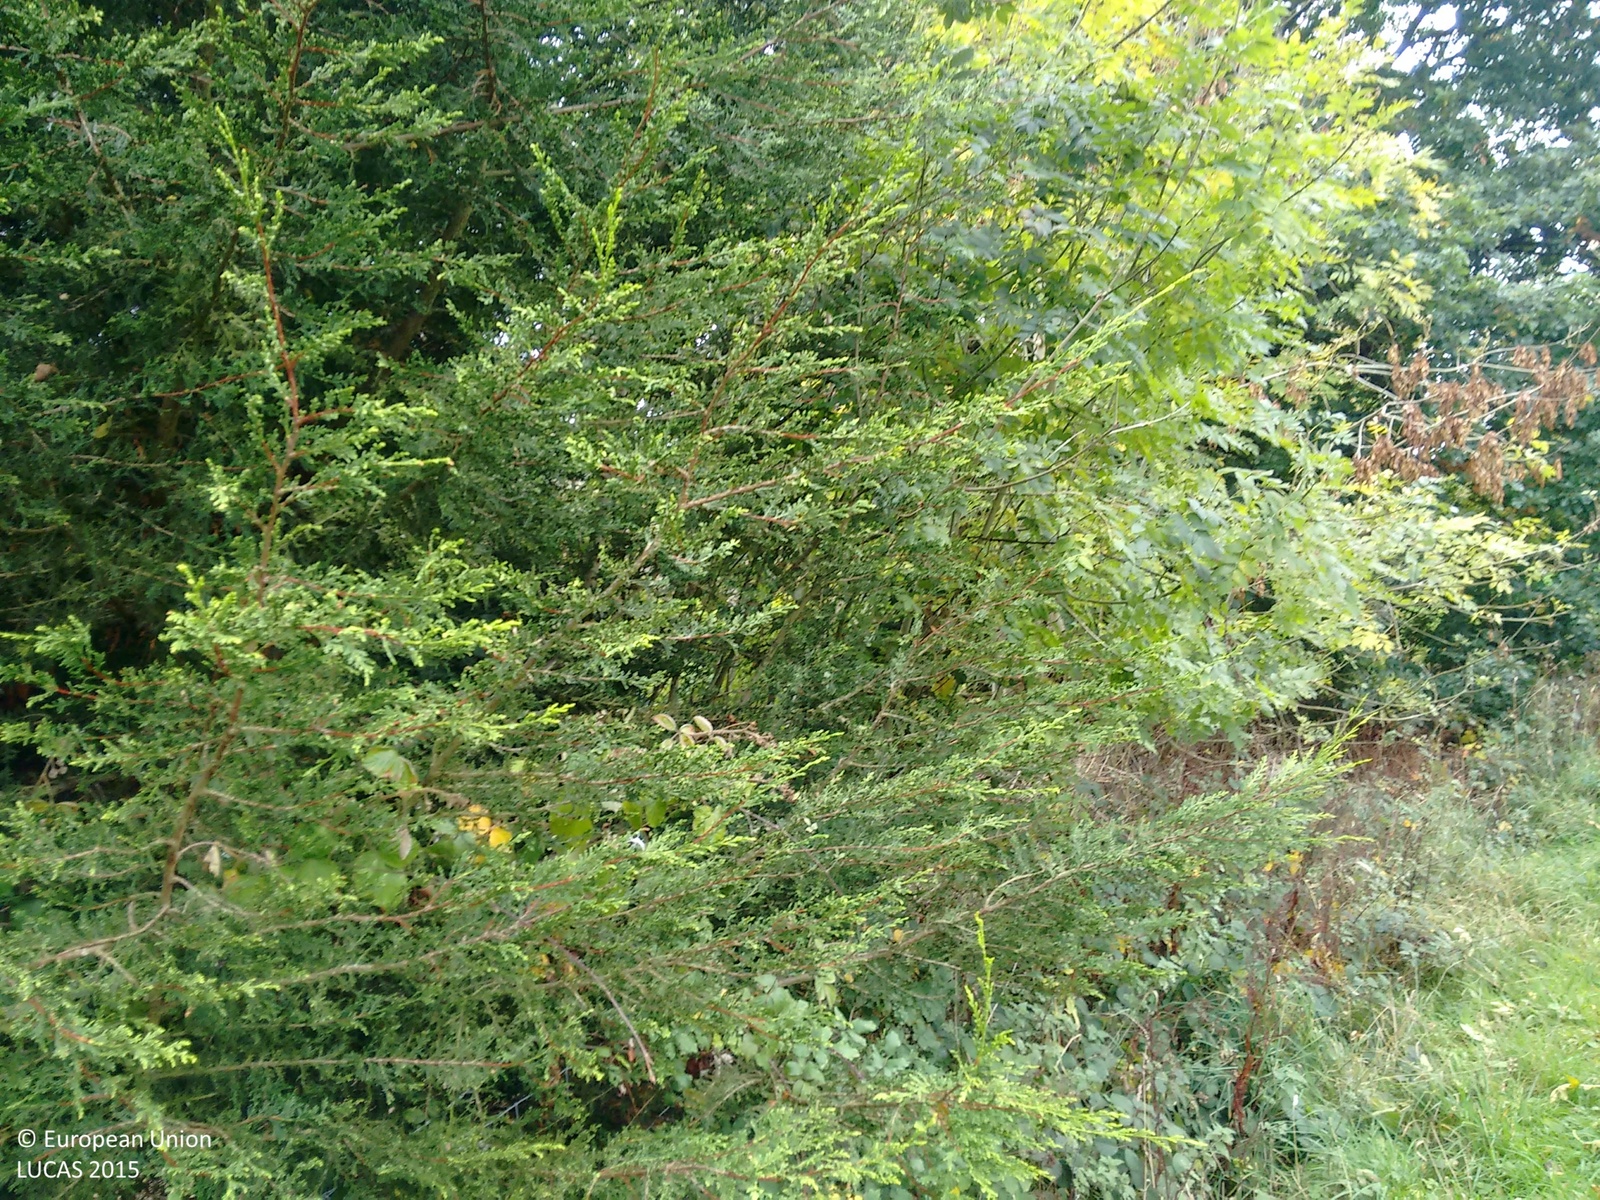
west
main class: Woodland
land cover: Other mixed woodland
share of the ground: > 75 %
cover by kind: broadleaved forest trees 40 %, coniferous forest trees 30 %, herbaceous plants 30 %
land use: Commerce
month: October
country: GB
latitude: 51.8665
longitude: -2.6011
